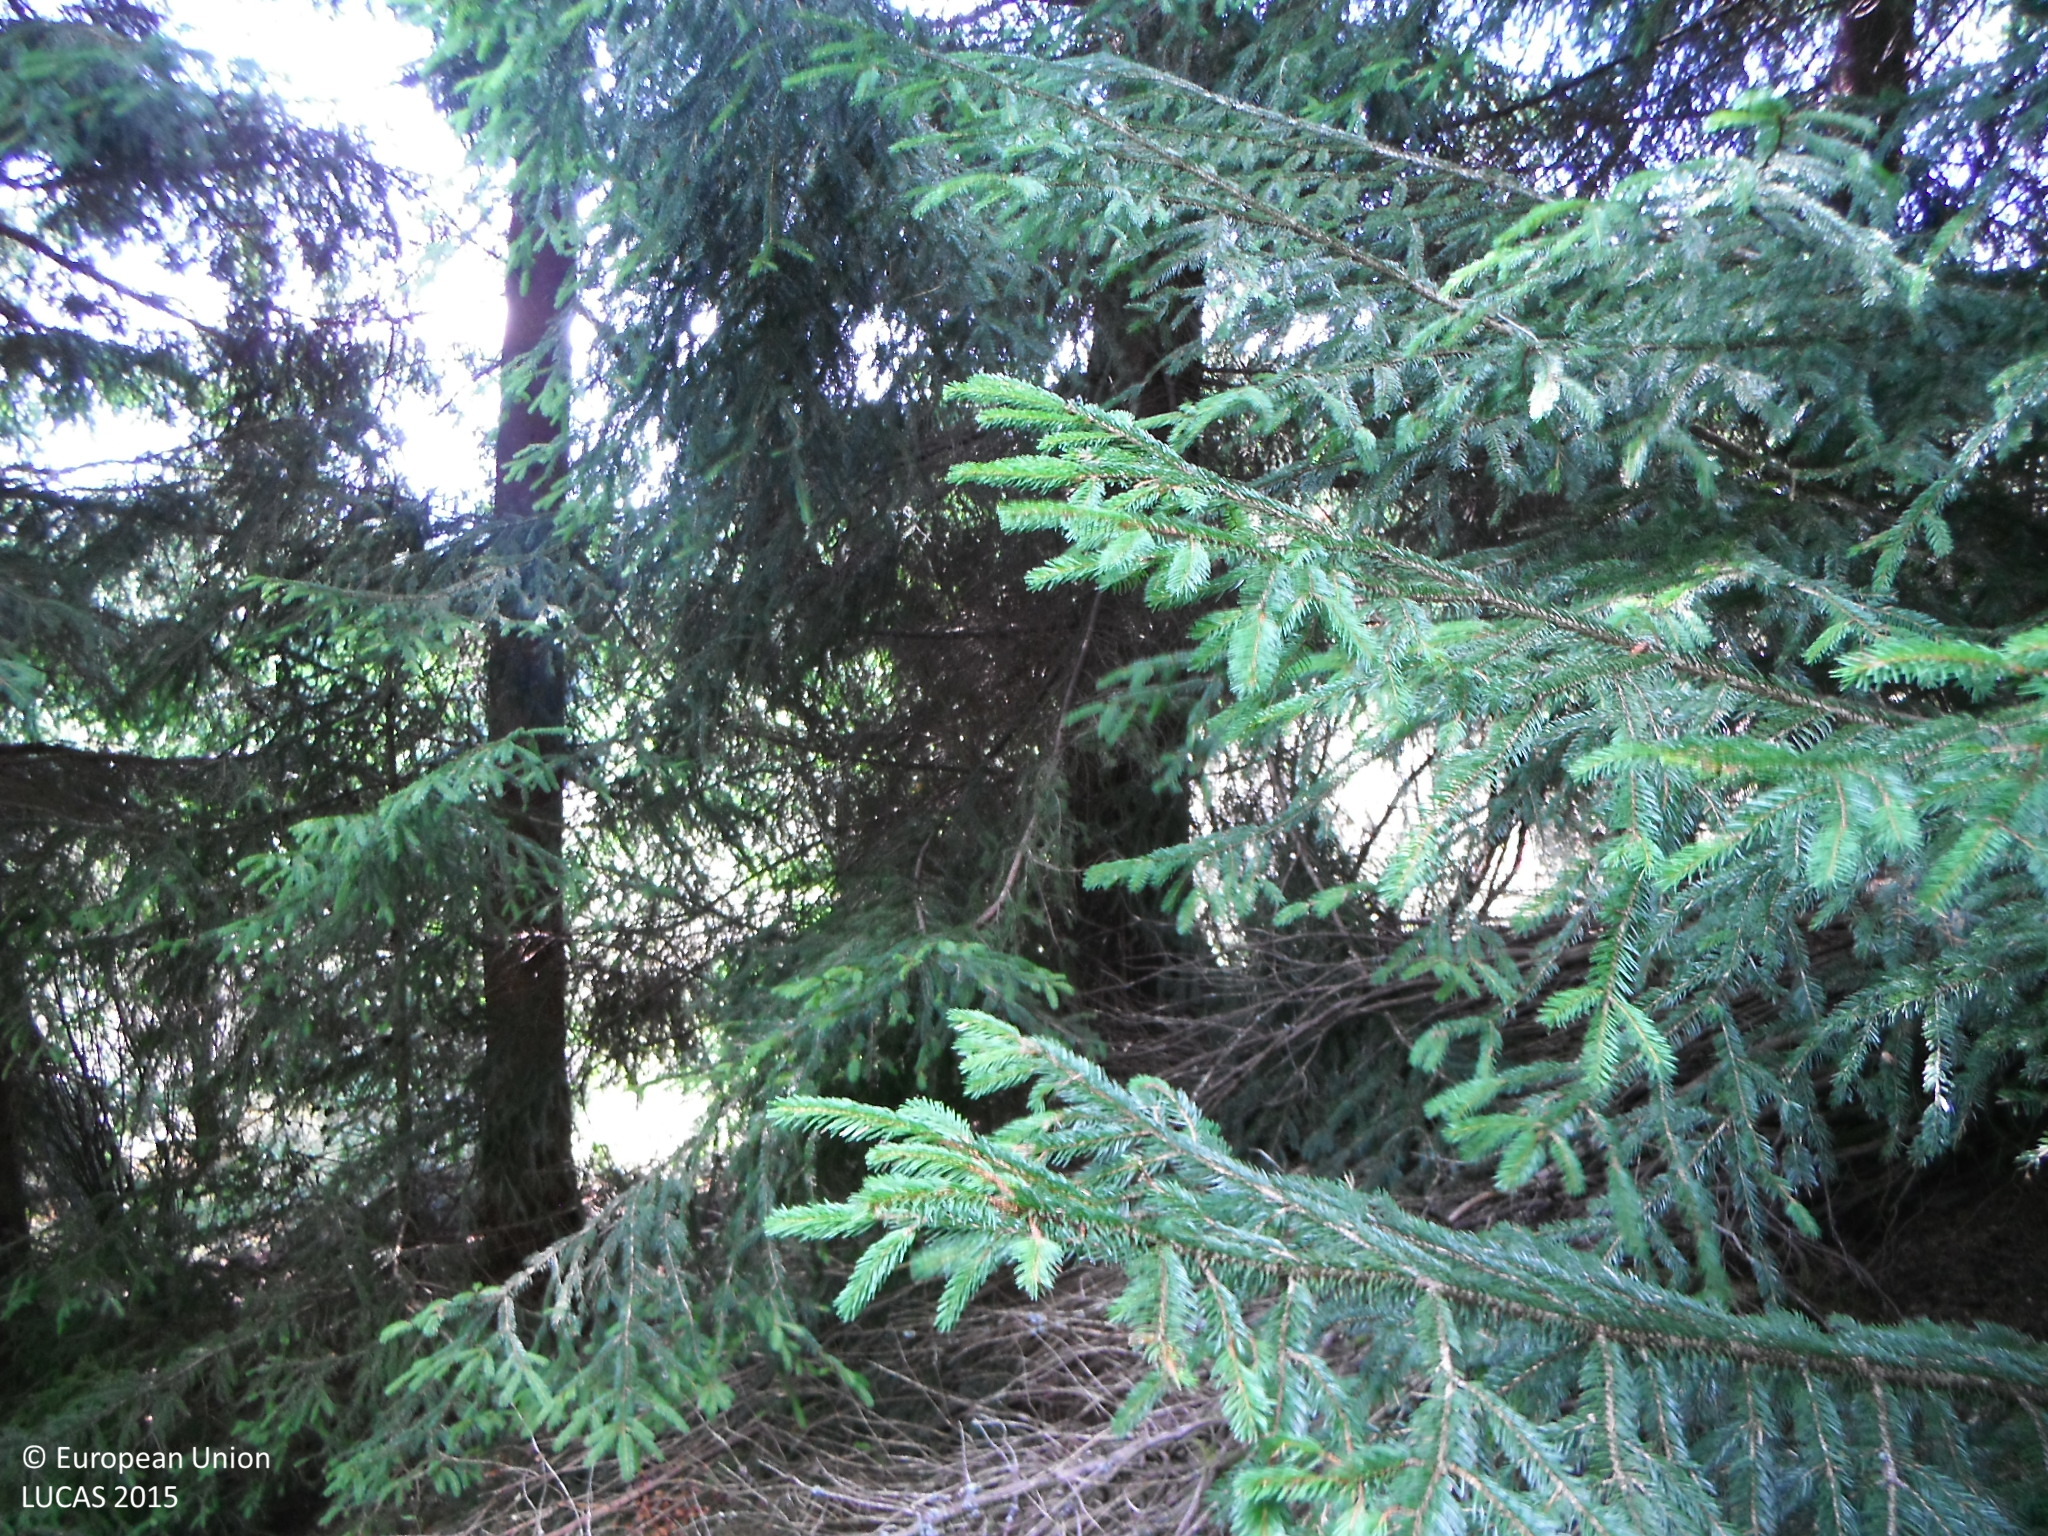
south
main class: Woodland
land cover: Spruce dominated coniferous woodland
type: alpine coniferous forest
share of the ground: > 75 %
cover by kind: coniferous forest trees 100 %
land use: Forestry
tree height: > 5 m
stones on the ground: > 50 %
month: August
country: SK
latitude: 48.8413
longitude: 20.1558
